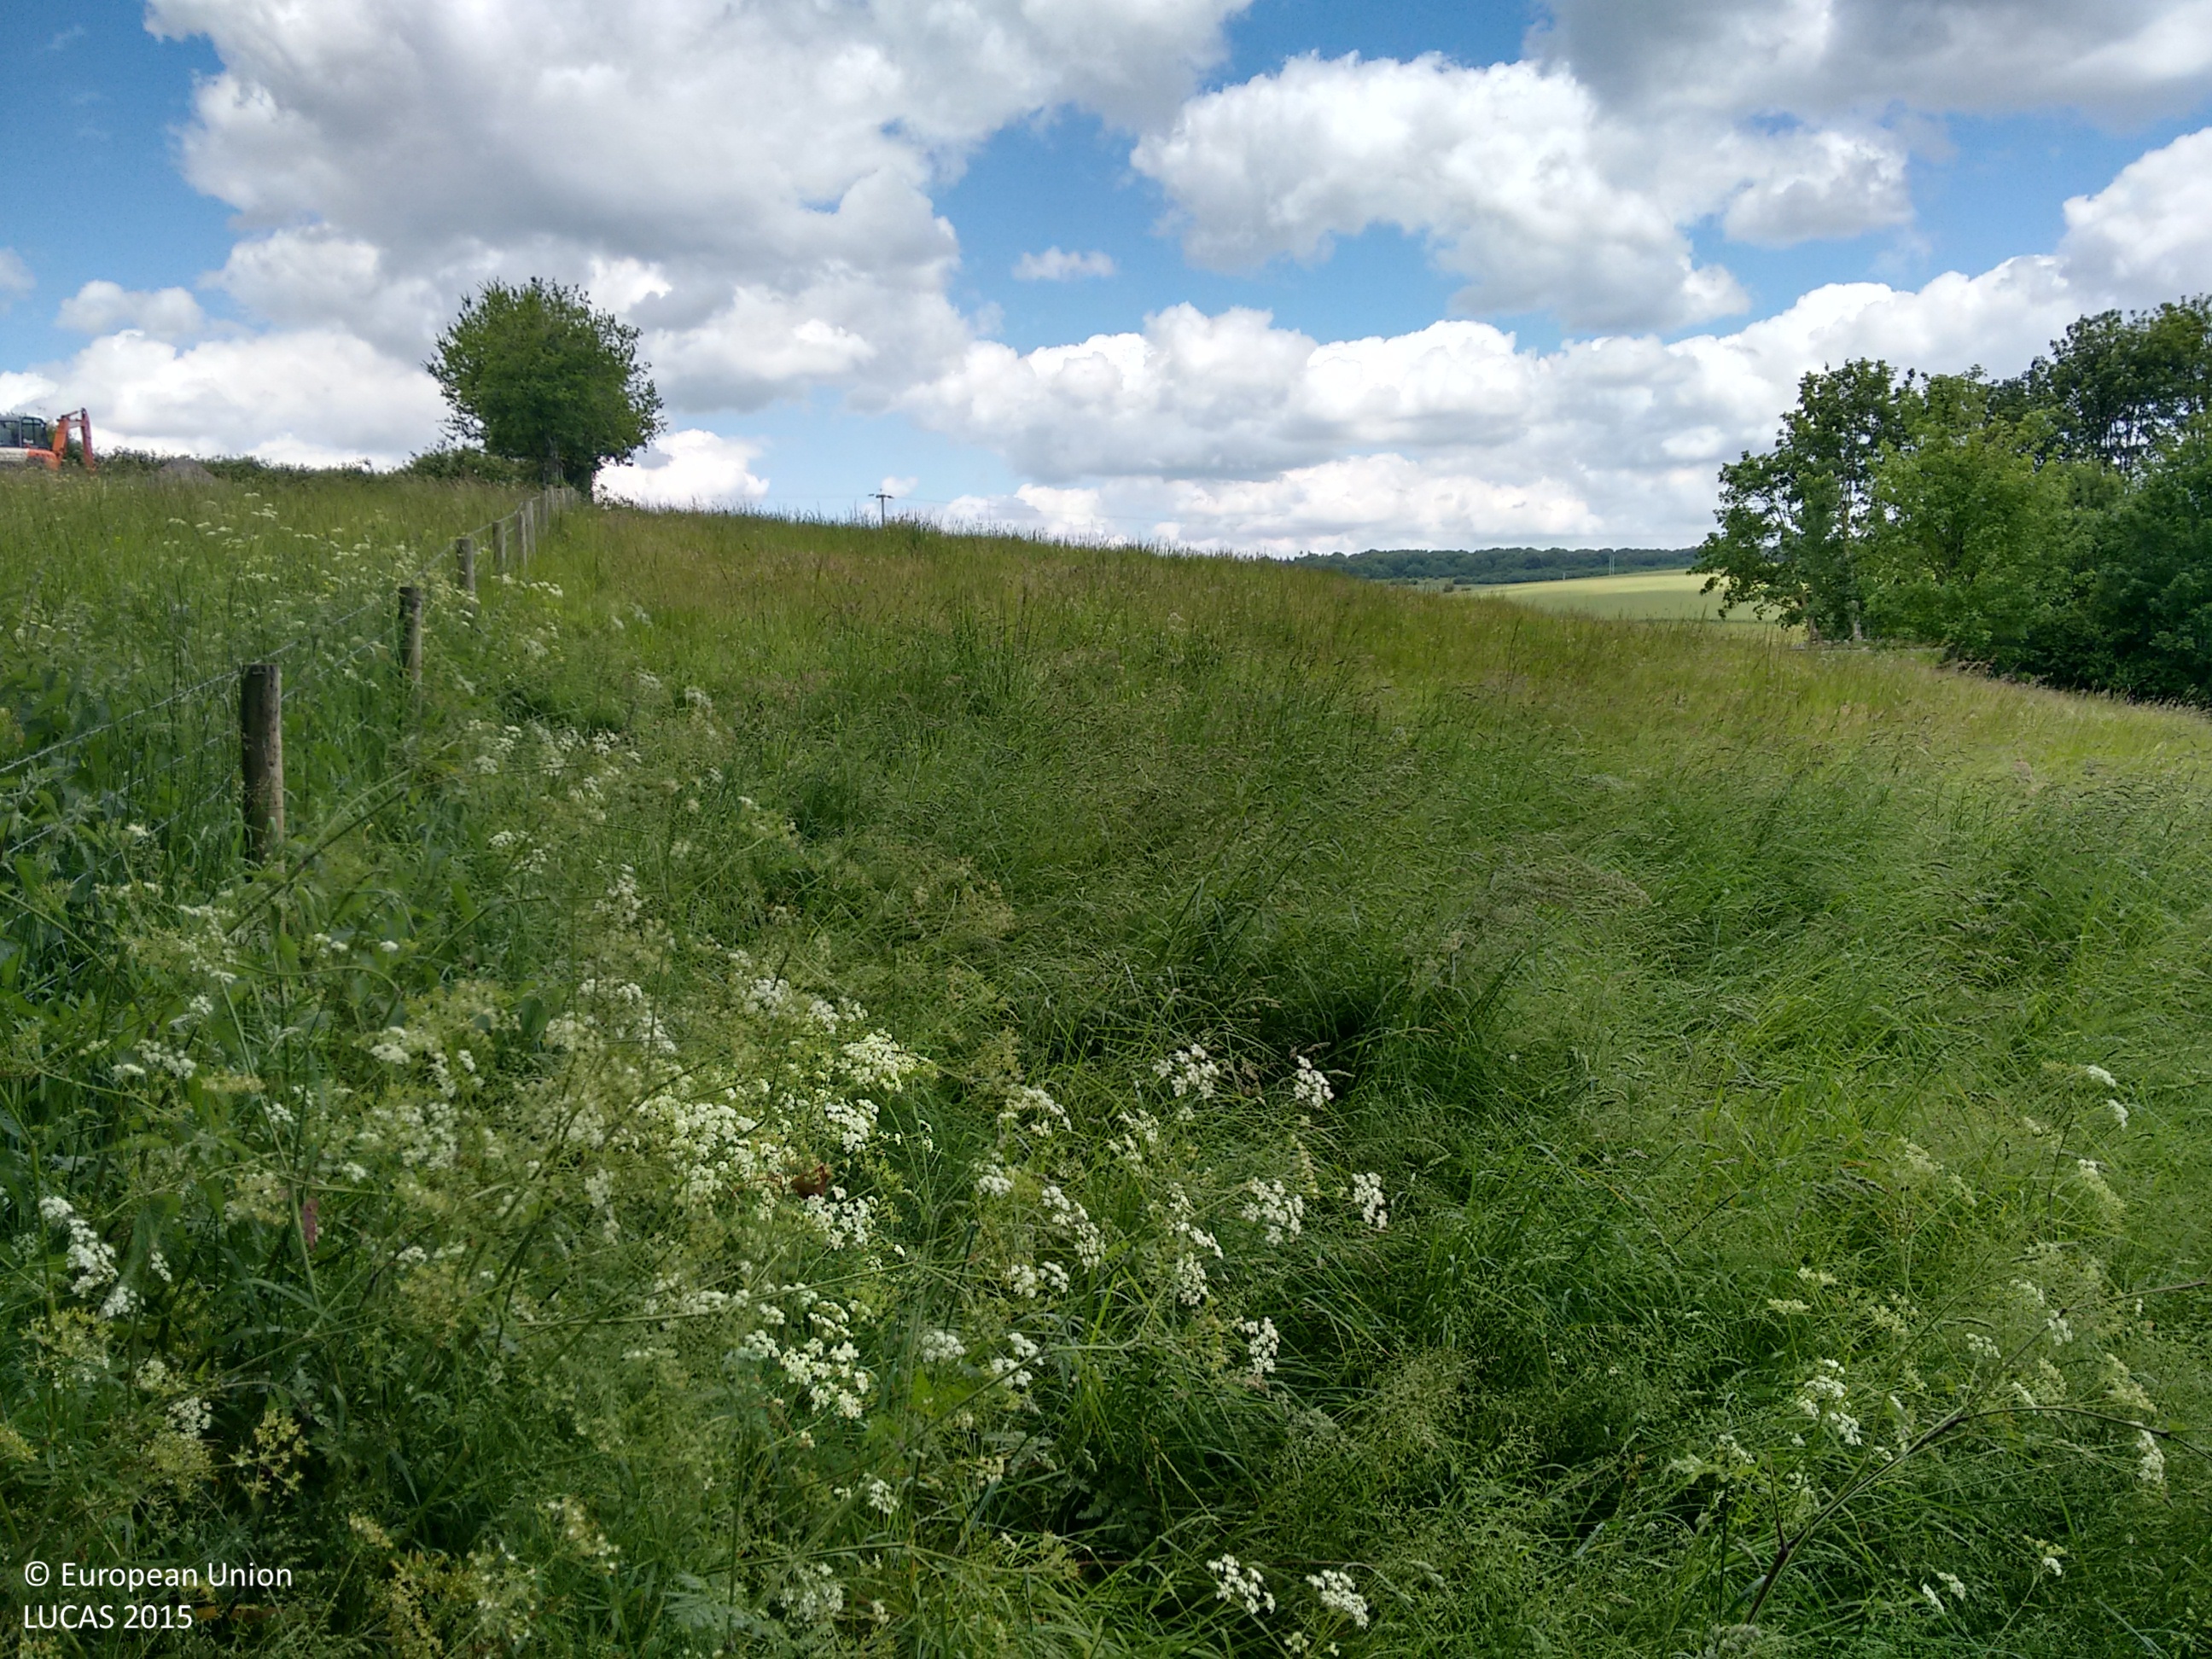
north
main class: Woodland
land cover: Broadleaved woodland
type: mesophytic deciduous forest
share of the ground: > 75 %
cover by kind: broadleaved forest trees 100 %
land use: Residential
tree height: > 5 m
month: June
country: GB
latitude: 51.0834
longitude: -1.9200
